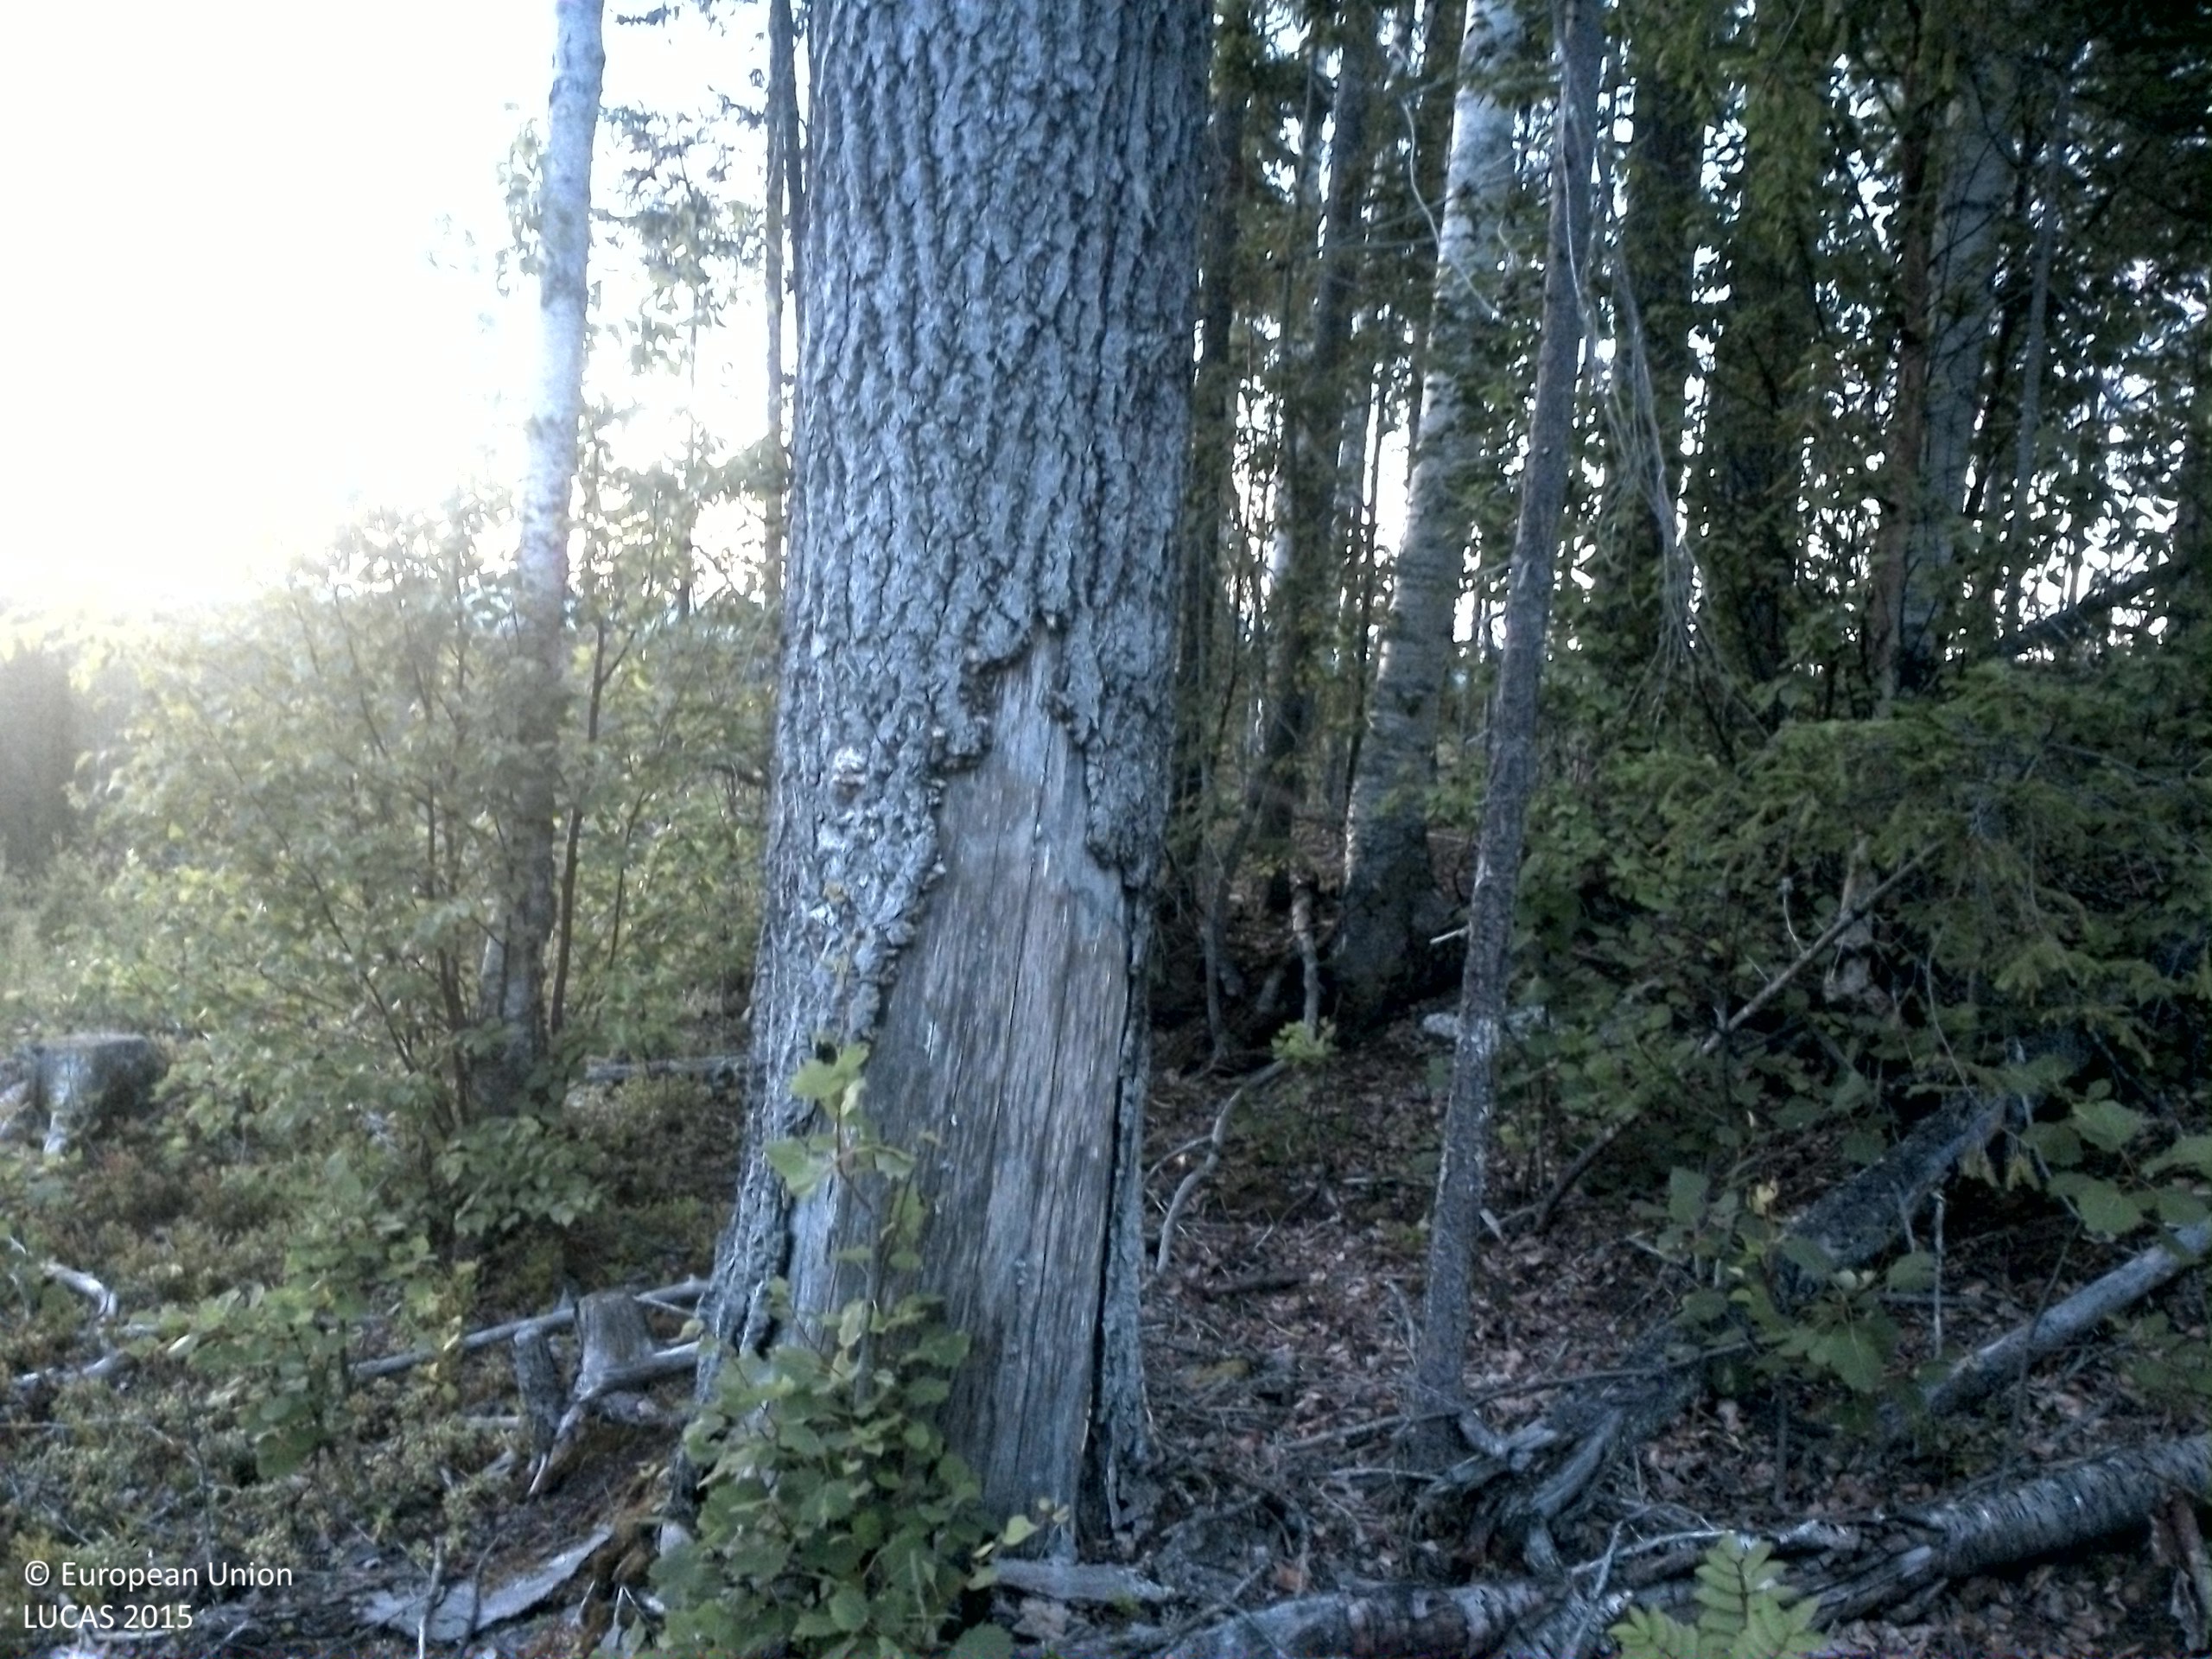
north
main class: Woodland
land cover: Broadleaved woodland
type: boreal forest
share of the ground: 25 - 50 %
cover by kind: herbaceous plants 40 %, broadleaved forest trees 30 %, shrubs 10 %, lichens and mosses 10 %, coniferous forest trees 5 %, unconsolidated bare surface 5 %
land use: Forestry
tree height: < 5 m
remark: Clear cut
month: August
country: SE
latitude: 63.5708
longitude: 16.1962
